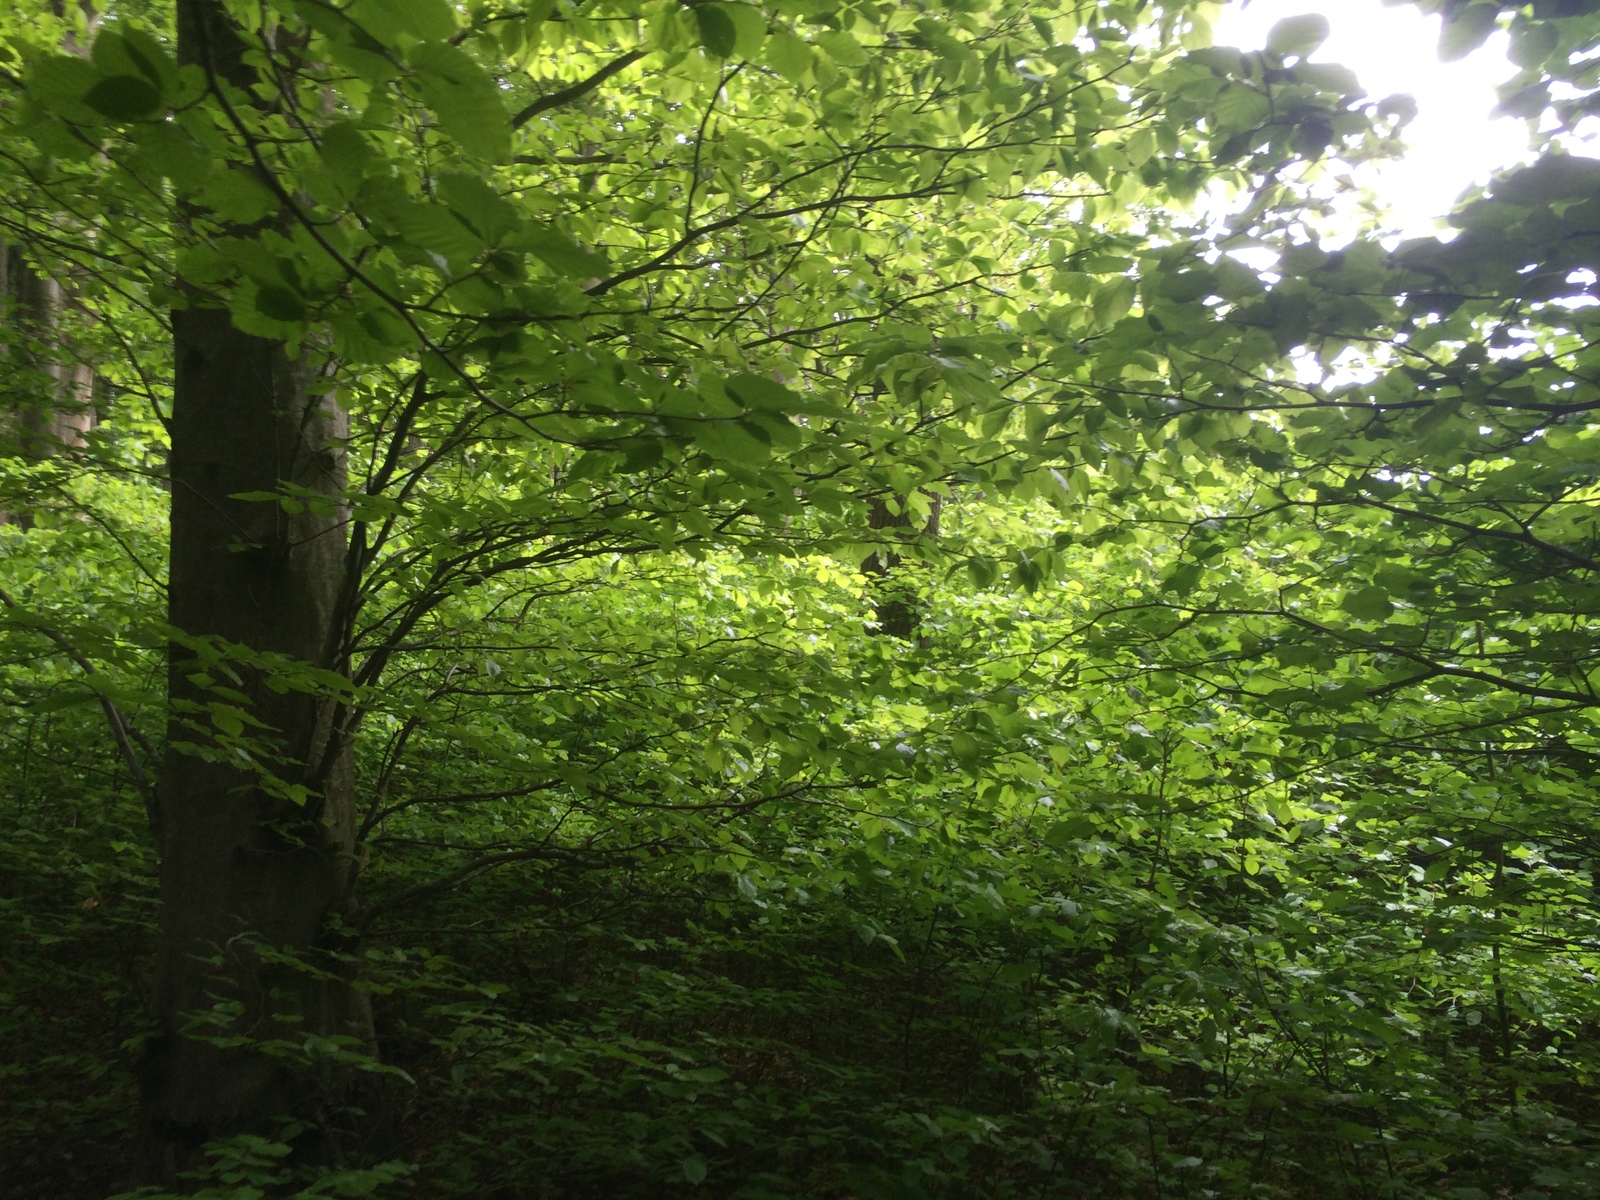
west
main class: Woodland
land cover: Broadleaved woodland
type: beech forest
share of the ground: > 75 %
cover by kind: broadleaved forest trees 100 %
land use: Forestry
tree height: > 5 m
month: May
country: AT
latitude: 48.0302
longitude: 16.2131
